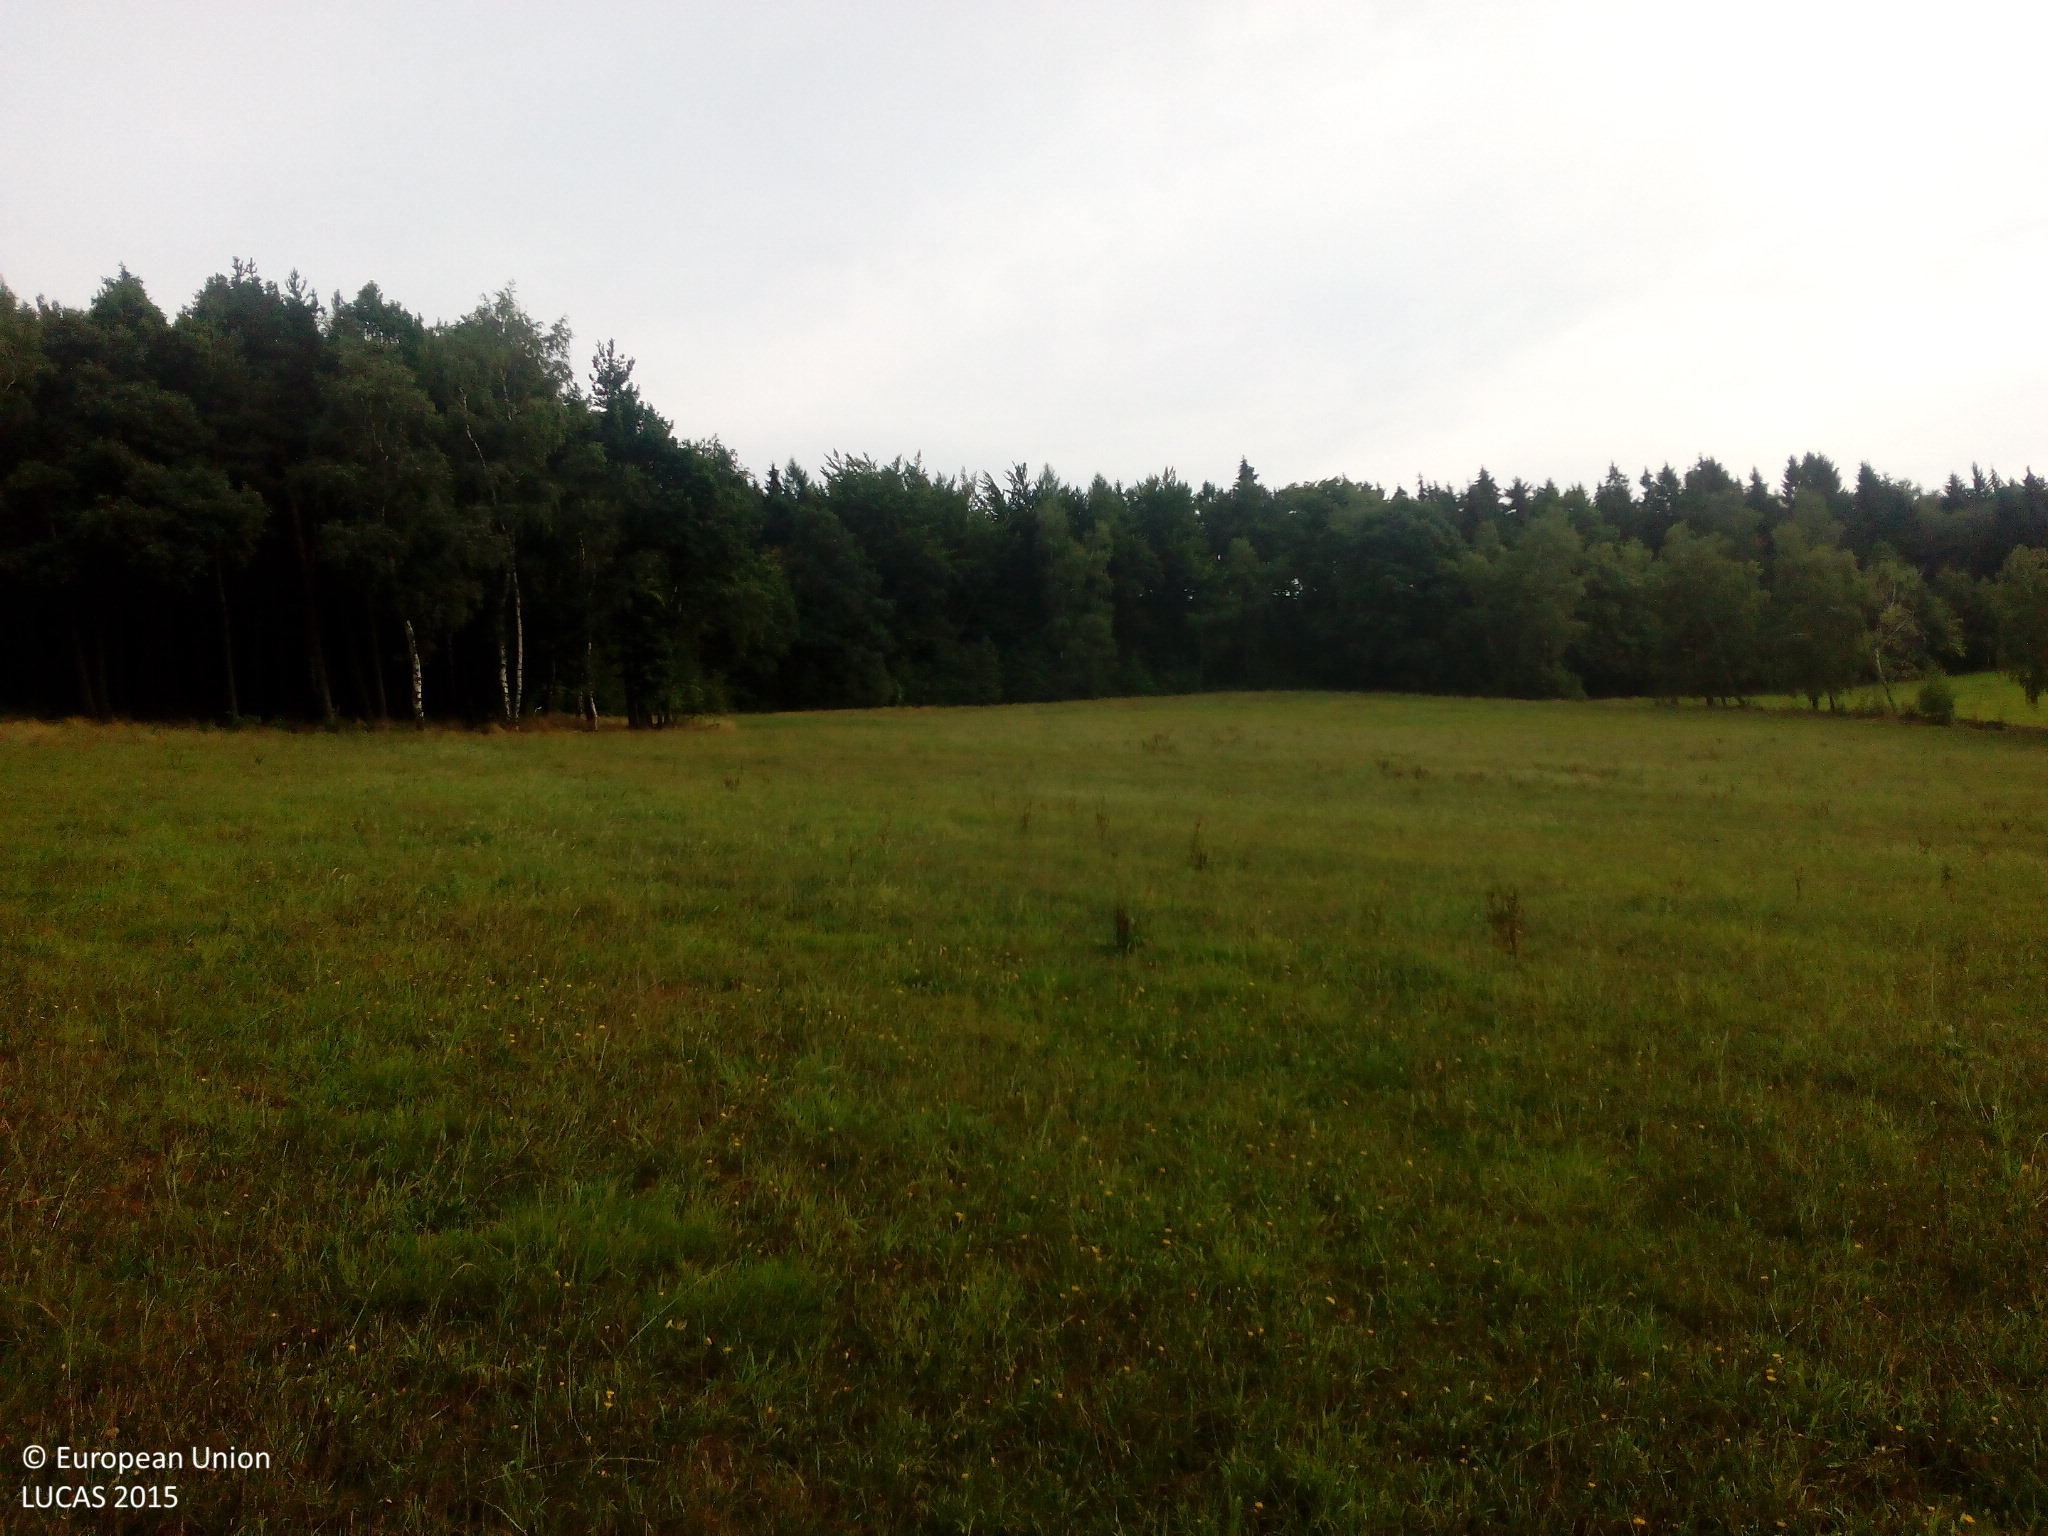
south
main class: Grassland
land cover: Grassland without tree/shrub cover
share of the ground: > 75 %
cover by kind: herbaceous plants 100 %
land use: Agriculture (excluding fallow land and kitchen gardens)
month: August
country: DE
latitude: 50.8345
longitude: 13.9910
